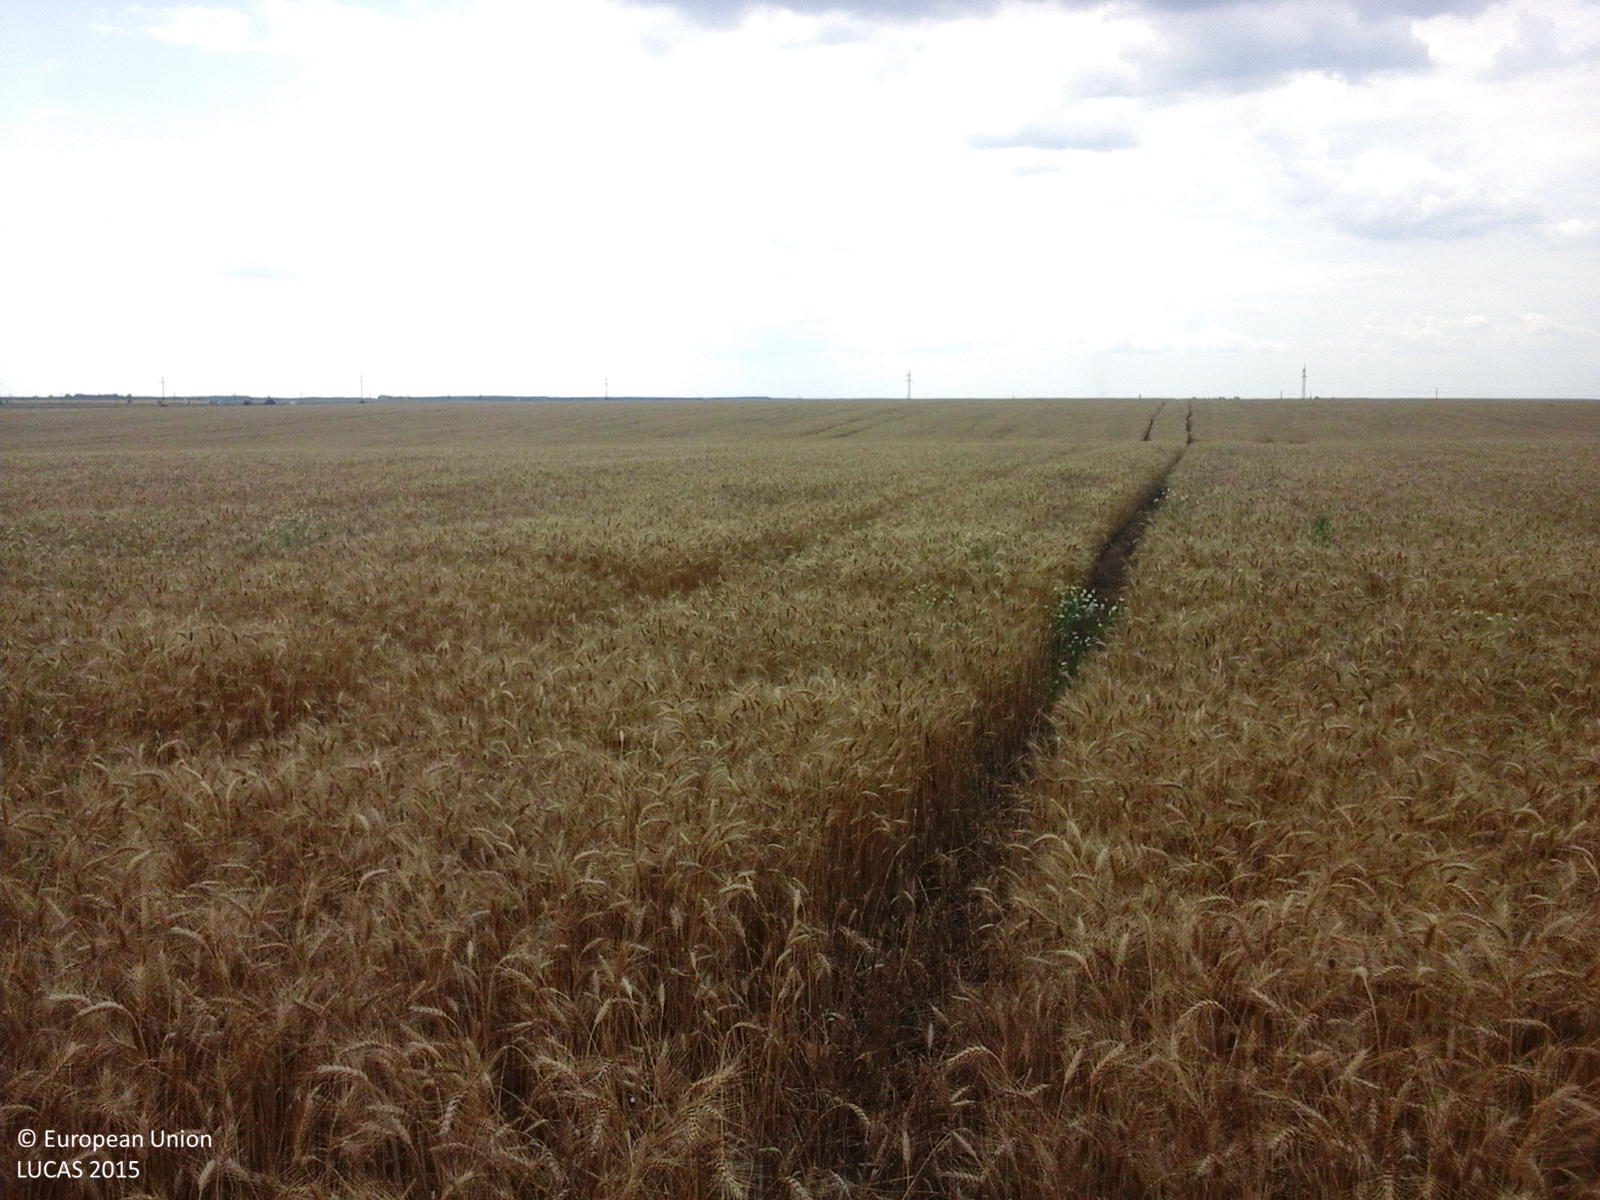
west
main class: Cropland
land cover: Common wheat
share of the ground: > 75 %
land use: Agriculture (excluding fallow land and kitchen gardens)
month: June
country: RO
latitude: 44.2139
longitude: 26.0340
